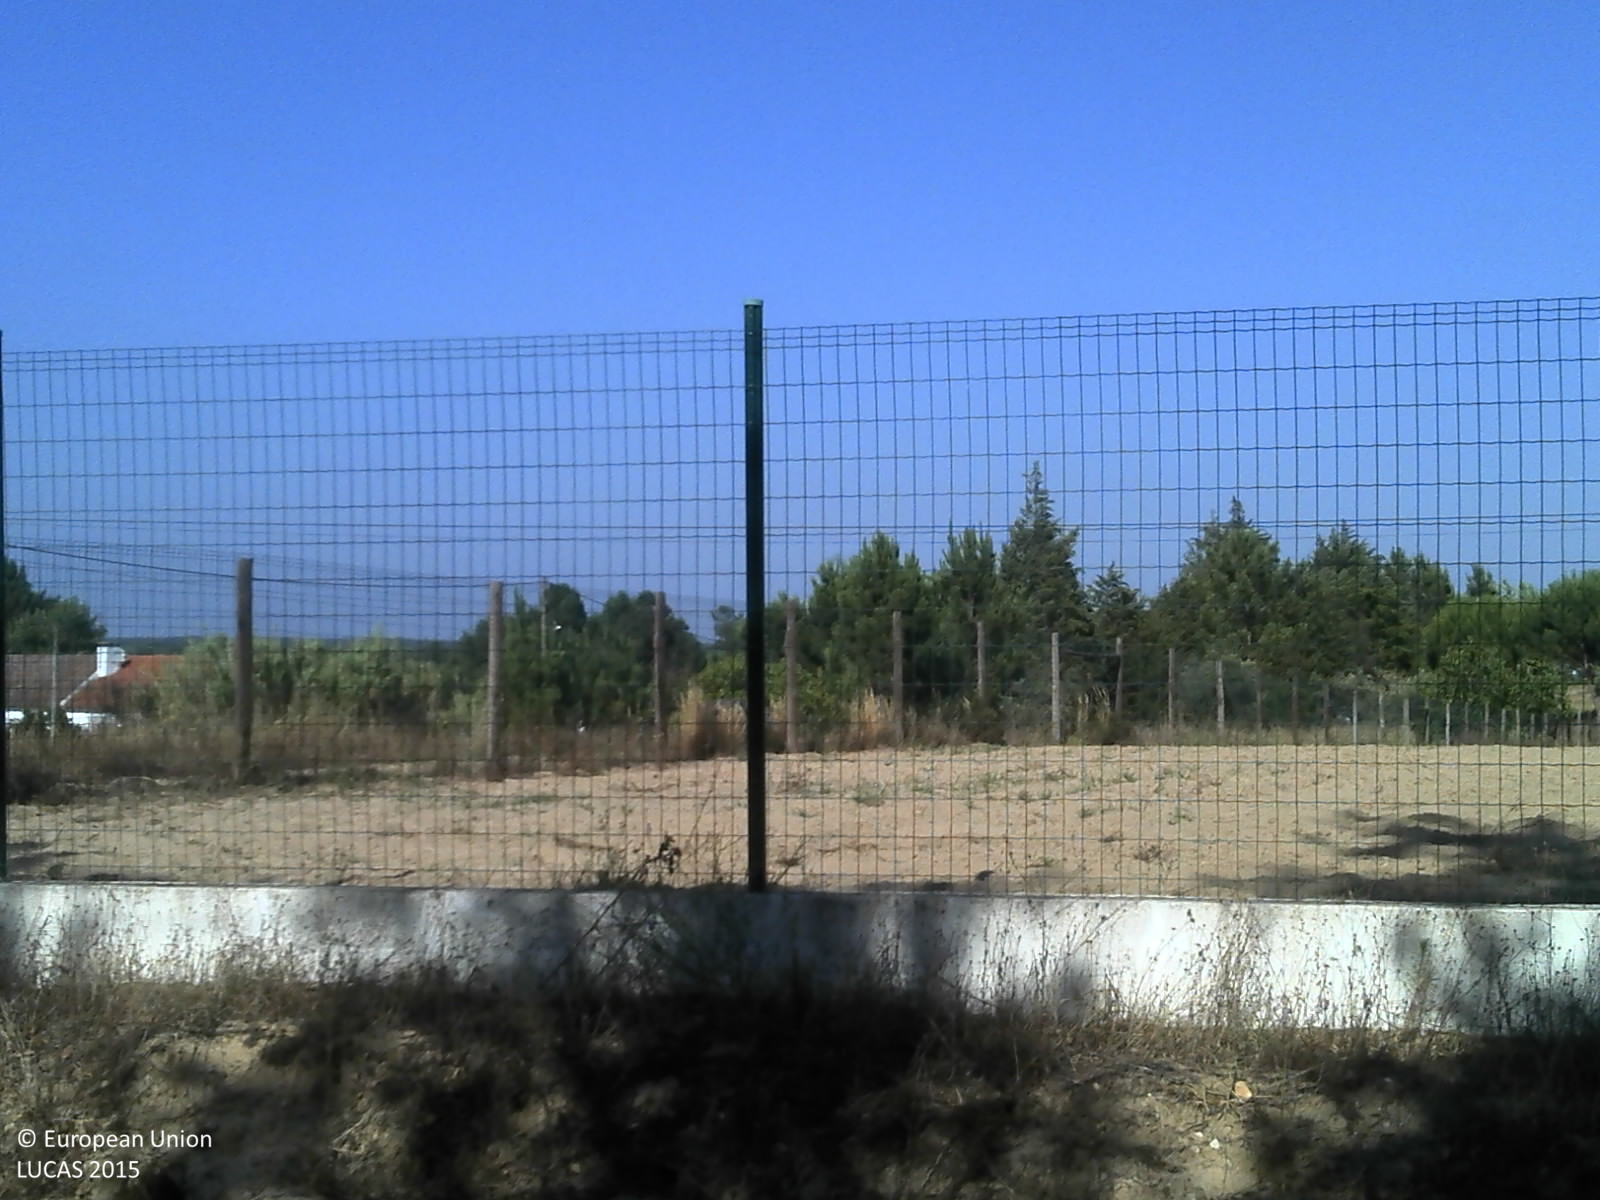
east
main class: Woodland
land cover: Pine dominated coniferous woodland
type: coniferous forest of the mediterranean region
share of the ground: 50 - 75 %
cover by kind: coniferous forest trees 65 %, unconsolidated bare surface 15 %, shrubs 10 %, broadleaved forest trees 5 %, herbaceous plants 5 %
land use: Forestry
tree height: > 5 m
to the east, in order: Pine dominated coniferous woodland; Broadleaved woodland; Fences; Tracks; Grass margins; Fences; Other bare soil; Fences; Other bare soil; Single bushes/trees; Grassland without tree/shrub cover; Pine dominated coniferous woodland; Tracks; Grassland without tree/shrub cover; Single bushes/trees; Grassland without tree/shrub cover
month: July
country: PT
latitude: 38.9682
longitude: -8.6126
